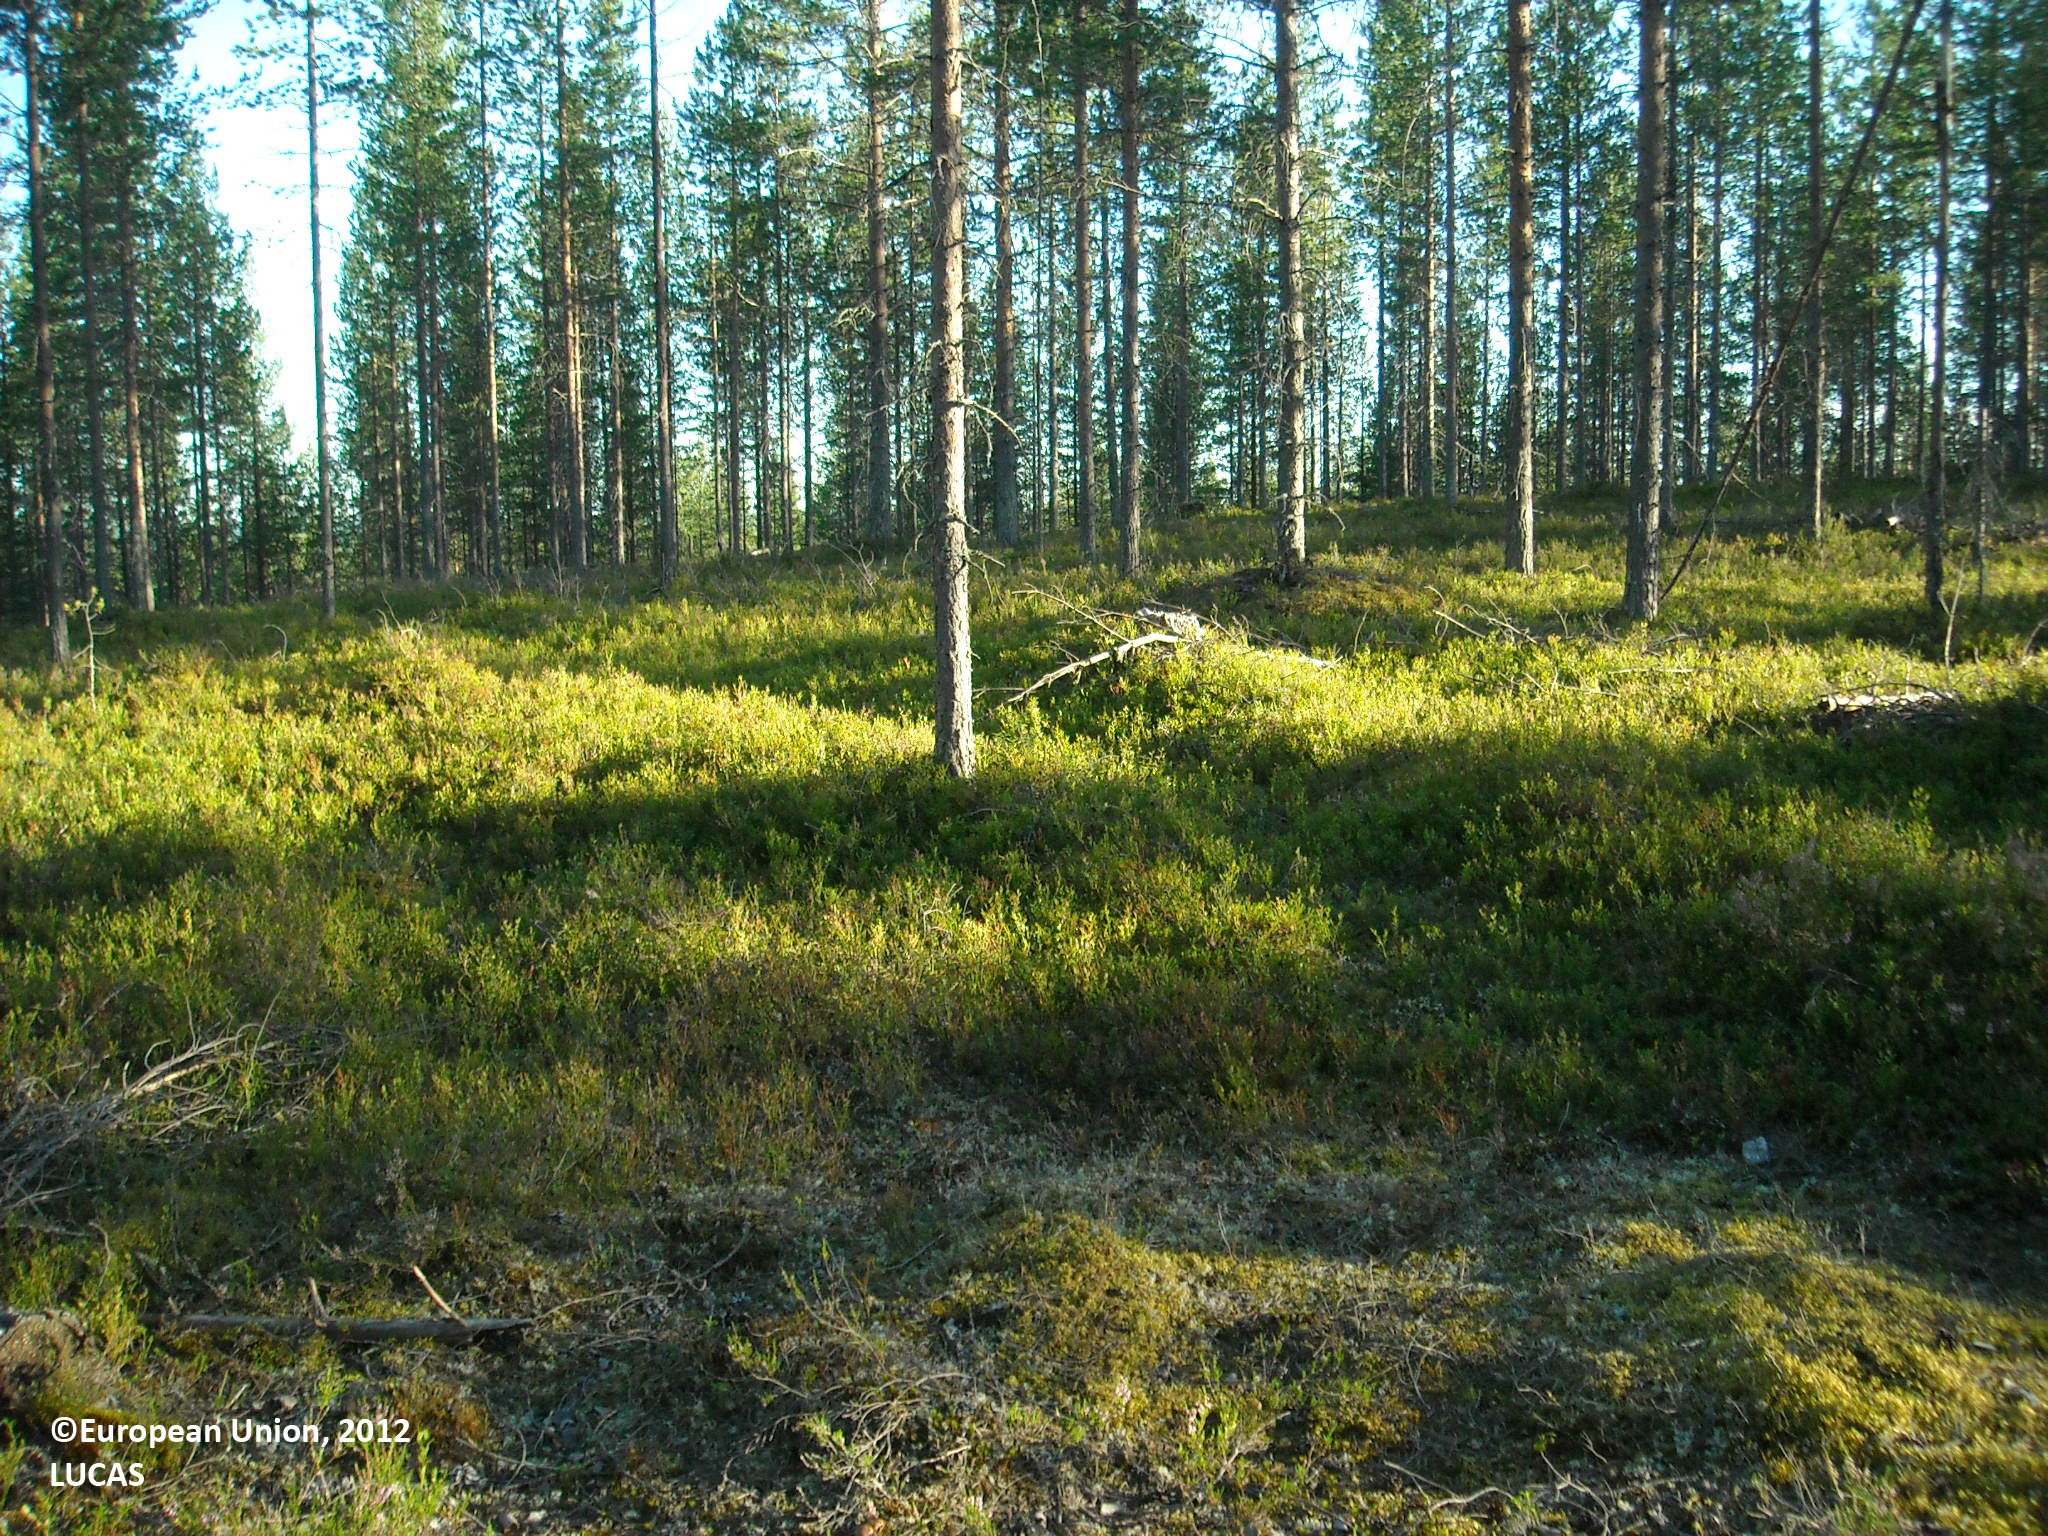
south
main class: Woodland
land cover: Pine dominated coniferous woodland
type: boreal forest
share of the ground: 25 - 50 %
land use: Forestry
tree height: > 5 m
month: August
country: FI
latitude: 65.4692
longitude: 27.7738
